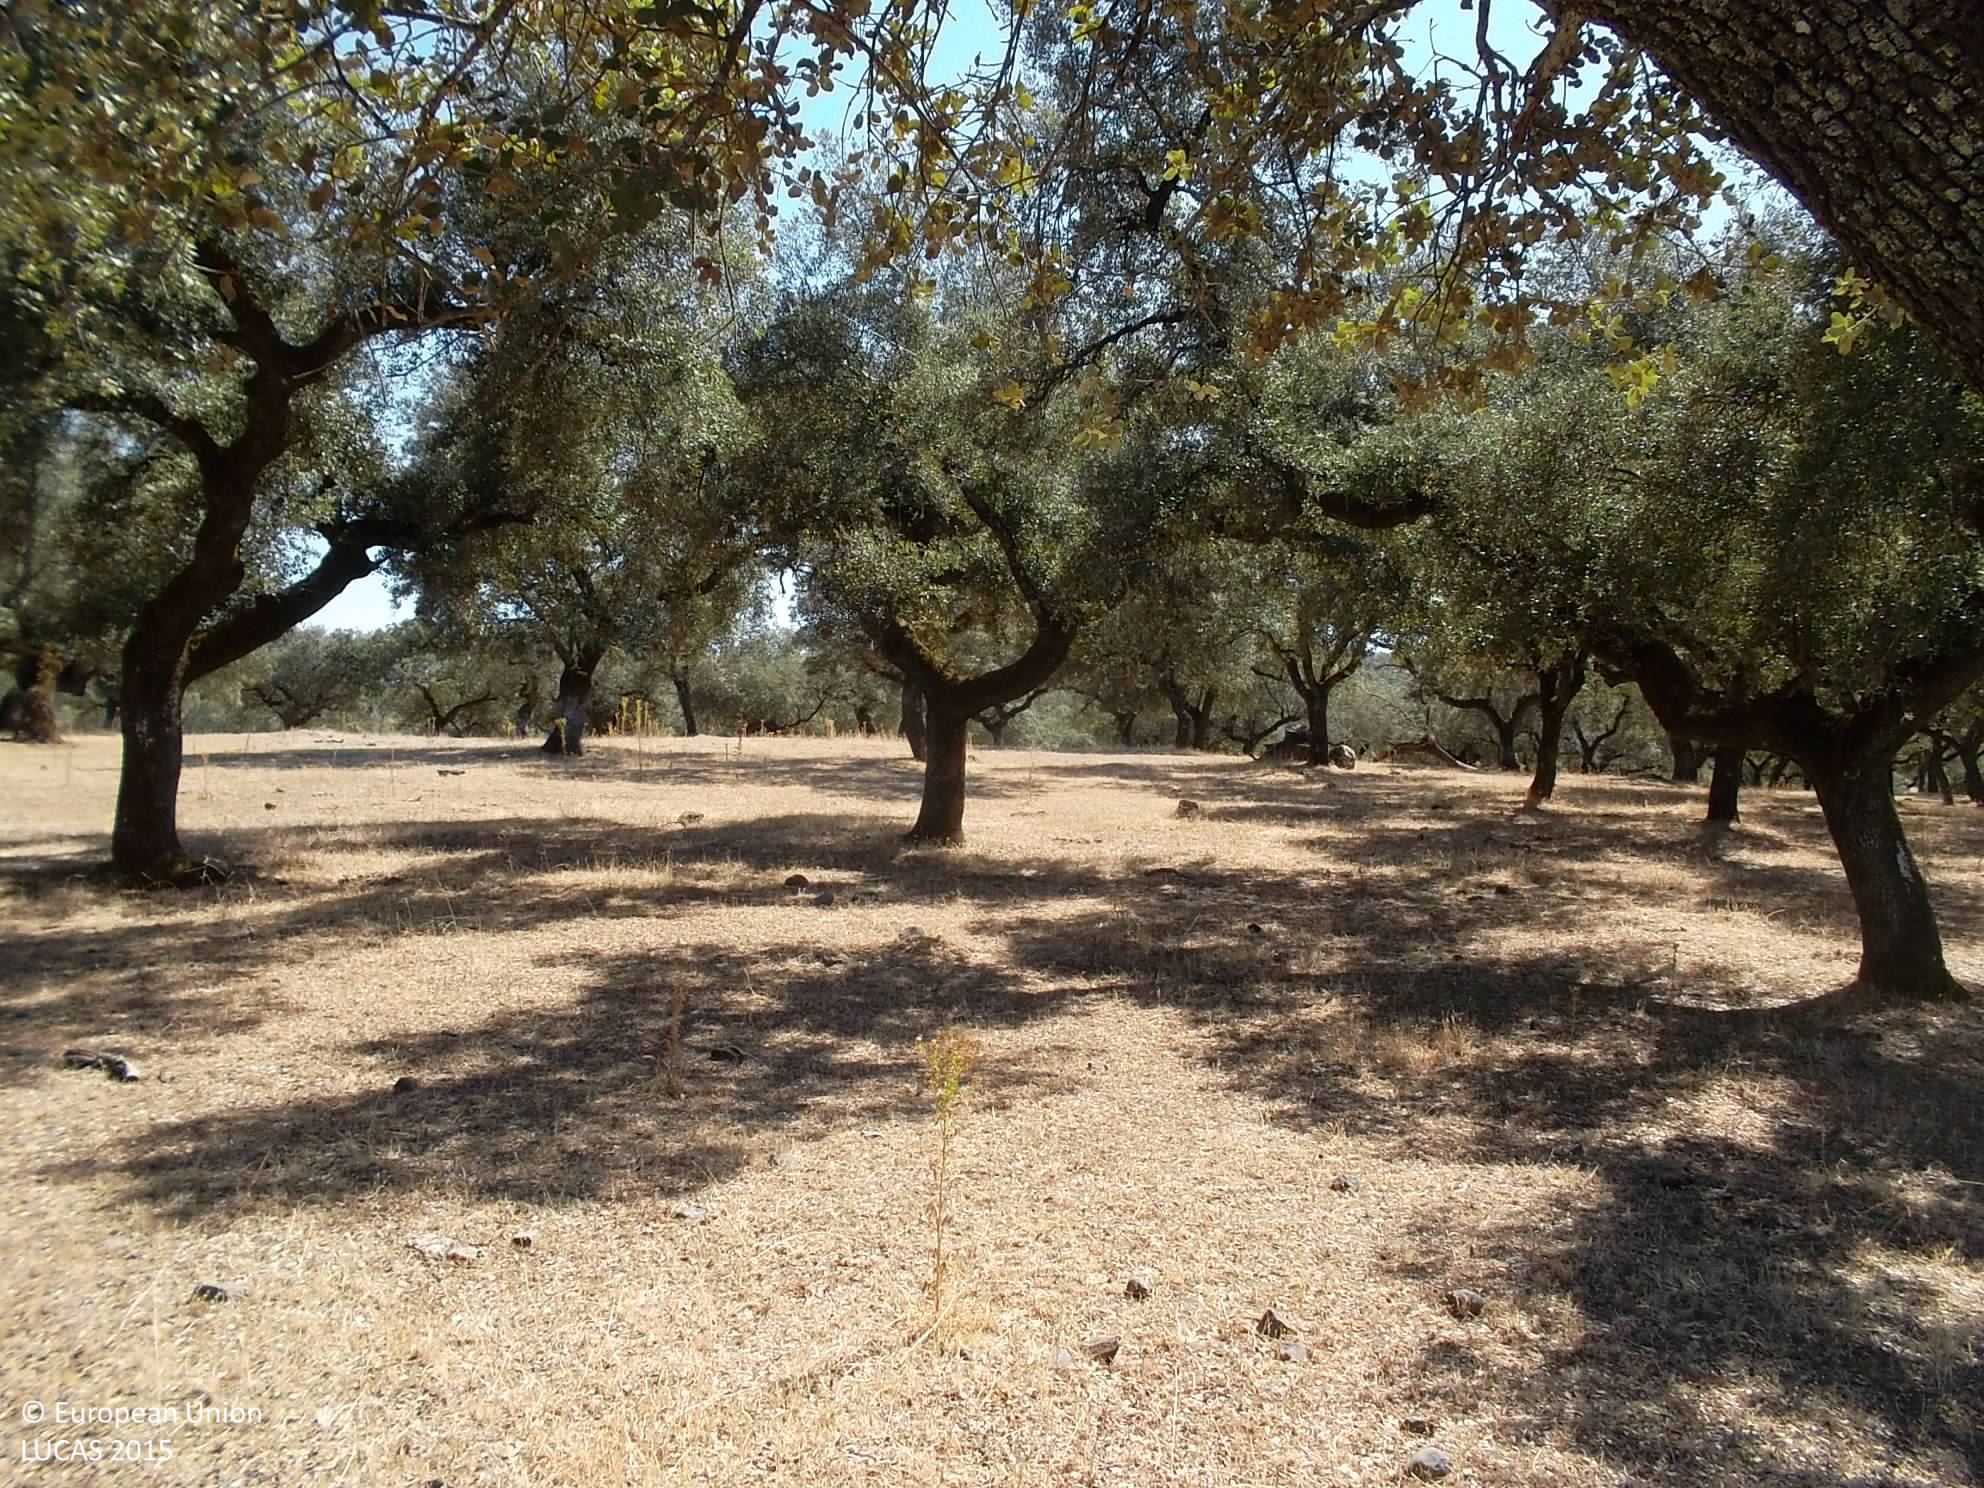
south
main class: Woodland
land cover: Broadleaved woodland
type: broadleaved evergreen forest
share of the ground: 50 - 75 %
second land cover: Grassland without tree/shrub cover
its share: 50 - 75 %
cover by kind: broadleaved forest trees 50 %, herbaceous plants 50 %
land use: Forestry
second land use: Agriculture (excluding fallow land and kitchen gardens)
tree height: > 5 m
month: August
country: ES
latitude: 38.4193
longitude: -6.6978
